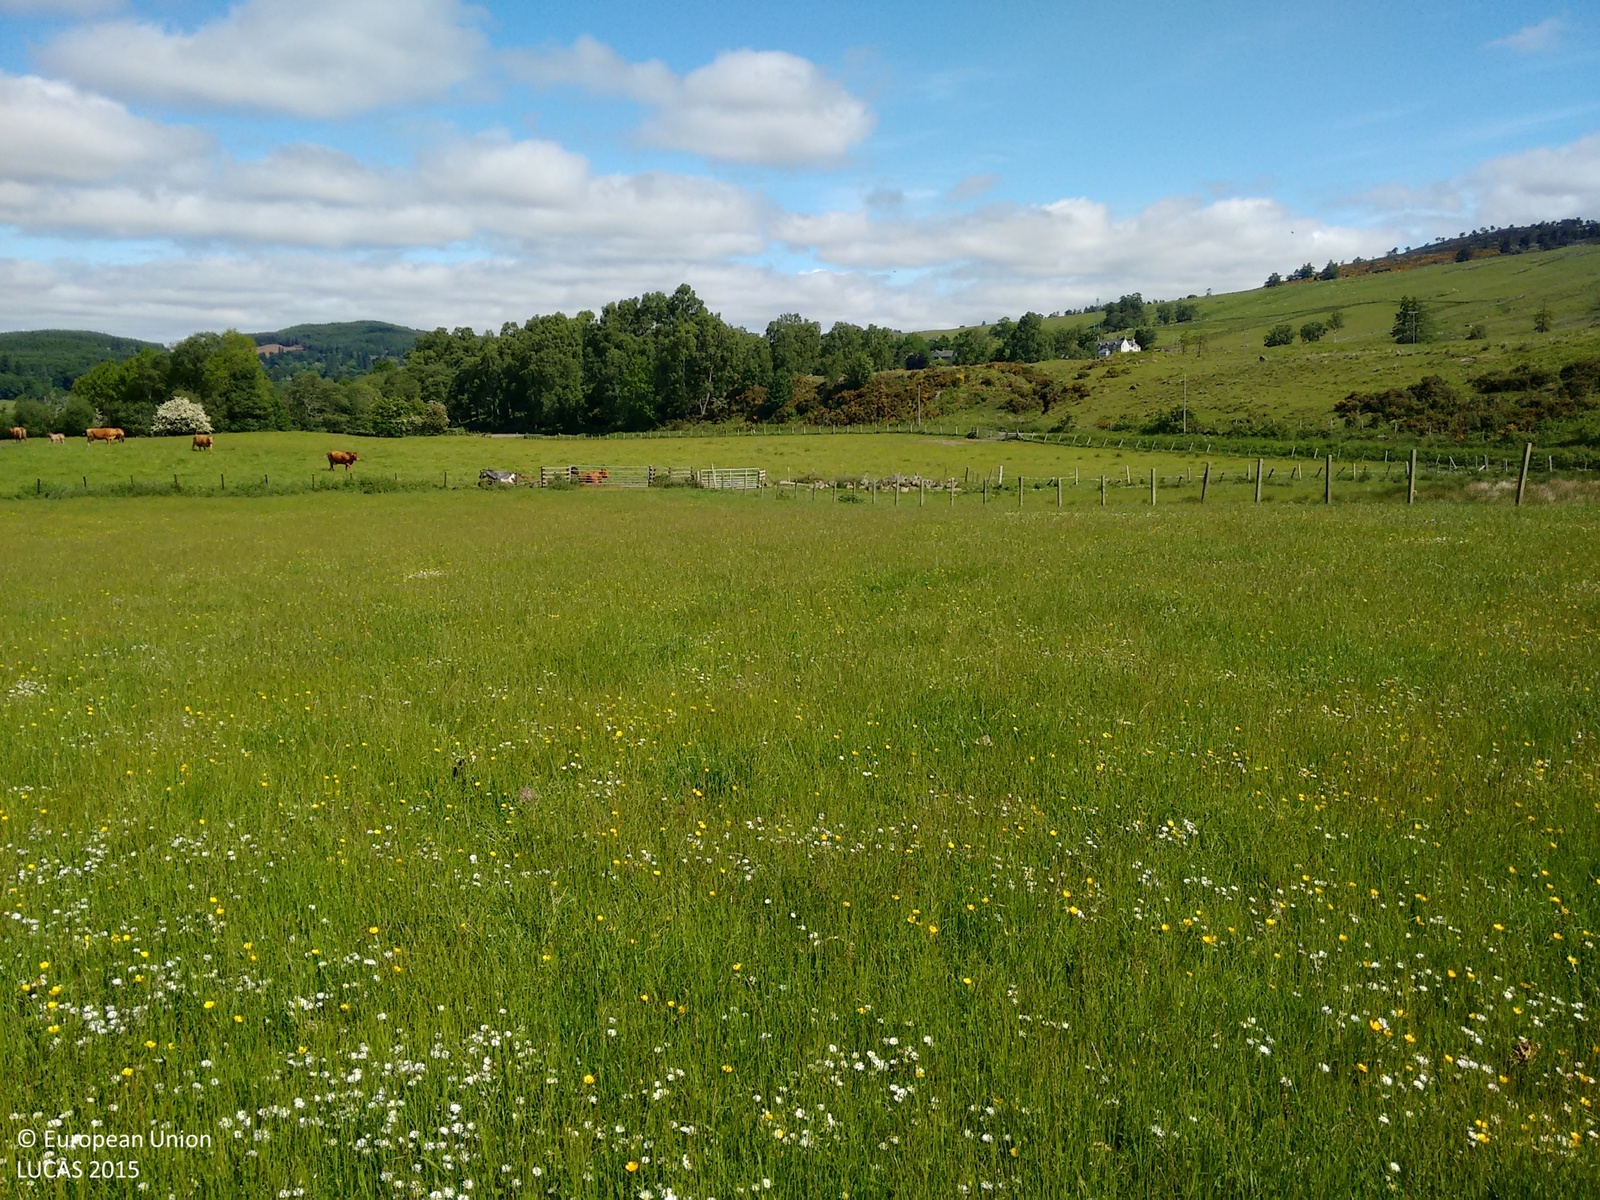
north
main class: Grassland
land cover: Grassland without tree/shrub cover
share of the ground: > 75 %
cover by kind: herbaceous plants 100 %
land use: Agriculture (excluding fallow land and kitchen gardens)
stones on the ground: < 10 %
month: June
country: GB
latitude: 56.6435
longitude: -3.6281
